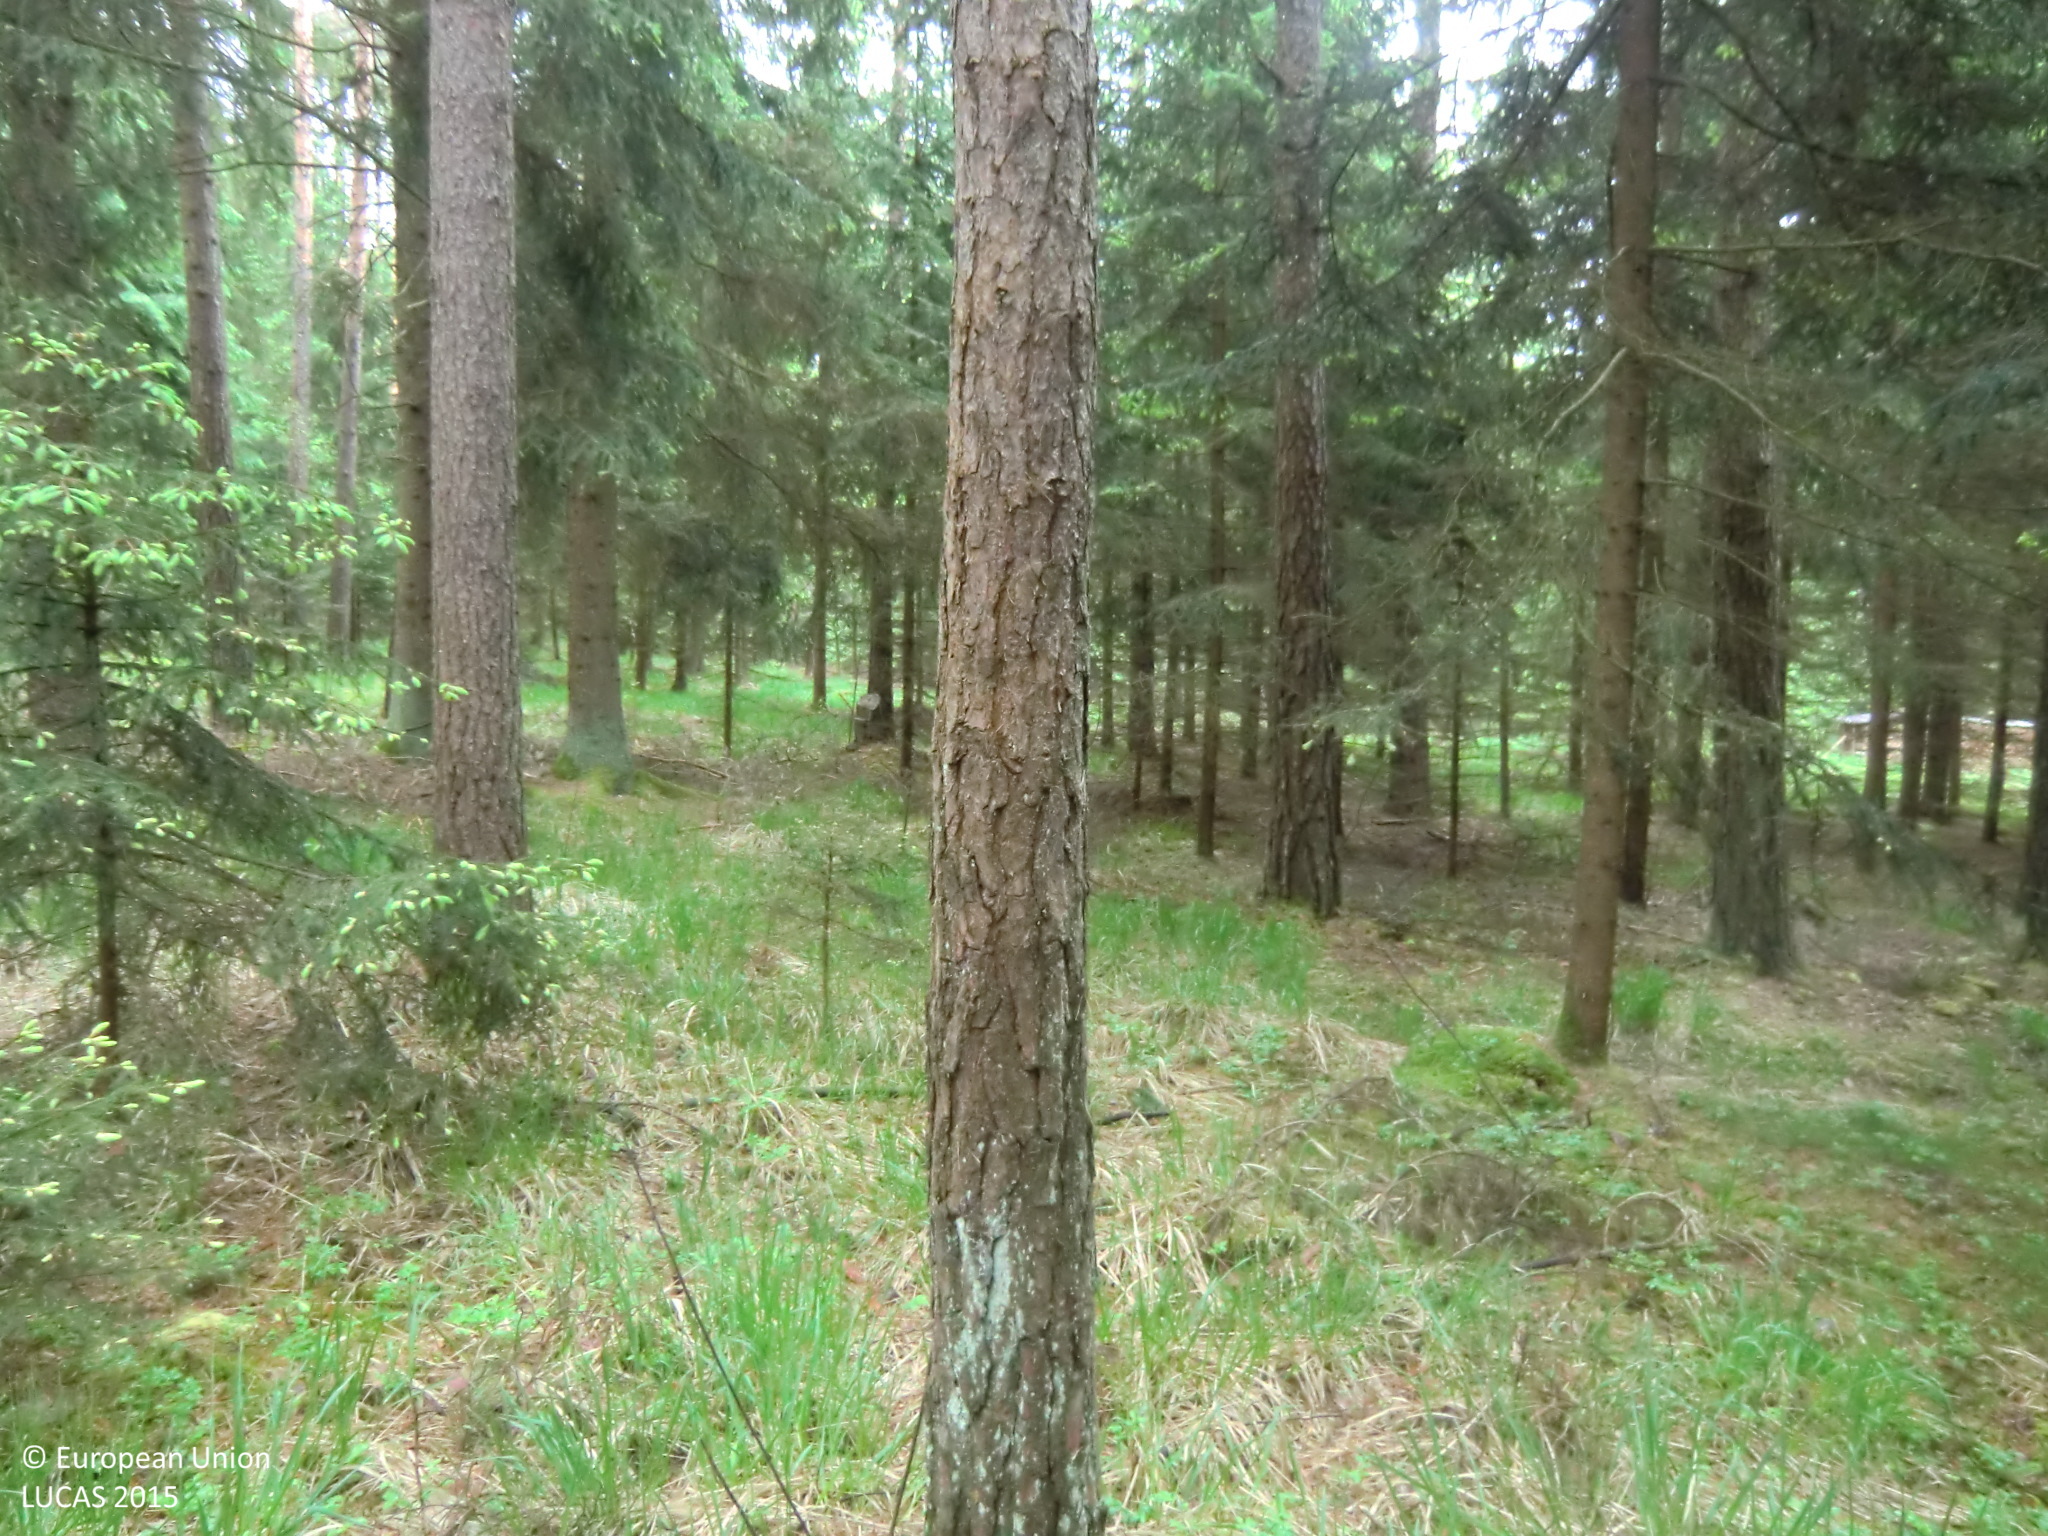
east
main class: Woodland
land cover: Pine dominated coniferous woodland
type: hemiboreal forest and nemoral coniferous forest and mixed broadleaved-coniferous forest
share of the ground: 50 - 75 %
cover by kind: coniferous forest trees 70 %, shrubs 10 %, herbaceous plants 10 %, unconsolidated bare surface 10 %
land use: Forestry
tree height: > 5 m
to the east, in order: Pine dominated coniferous woodland; Tracks; Pine dominated coniferous woodland; Spruce dominated coniferous woodland; Tracks; Pine dominated coniferous woodland; Tracks; Spruce dominated coniferous woodland; Tracks; Other coniferous woodland; Tracks; Shrubland with sparse tree cover; Other coniferous woodland
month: May
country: AT
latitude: 48.3874
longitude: 14.4162
